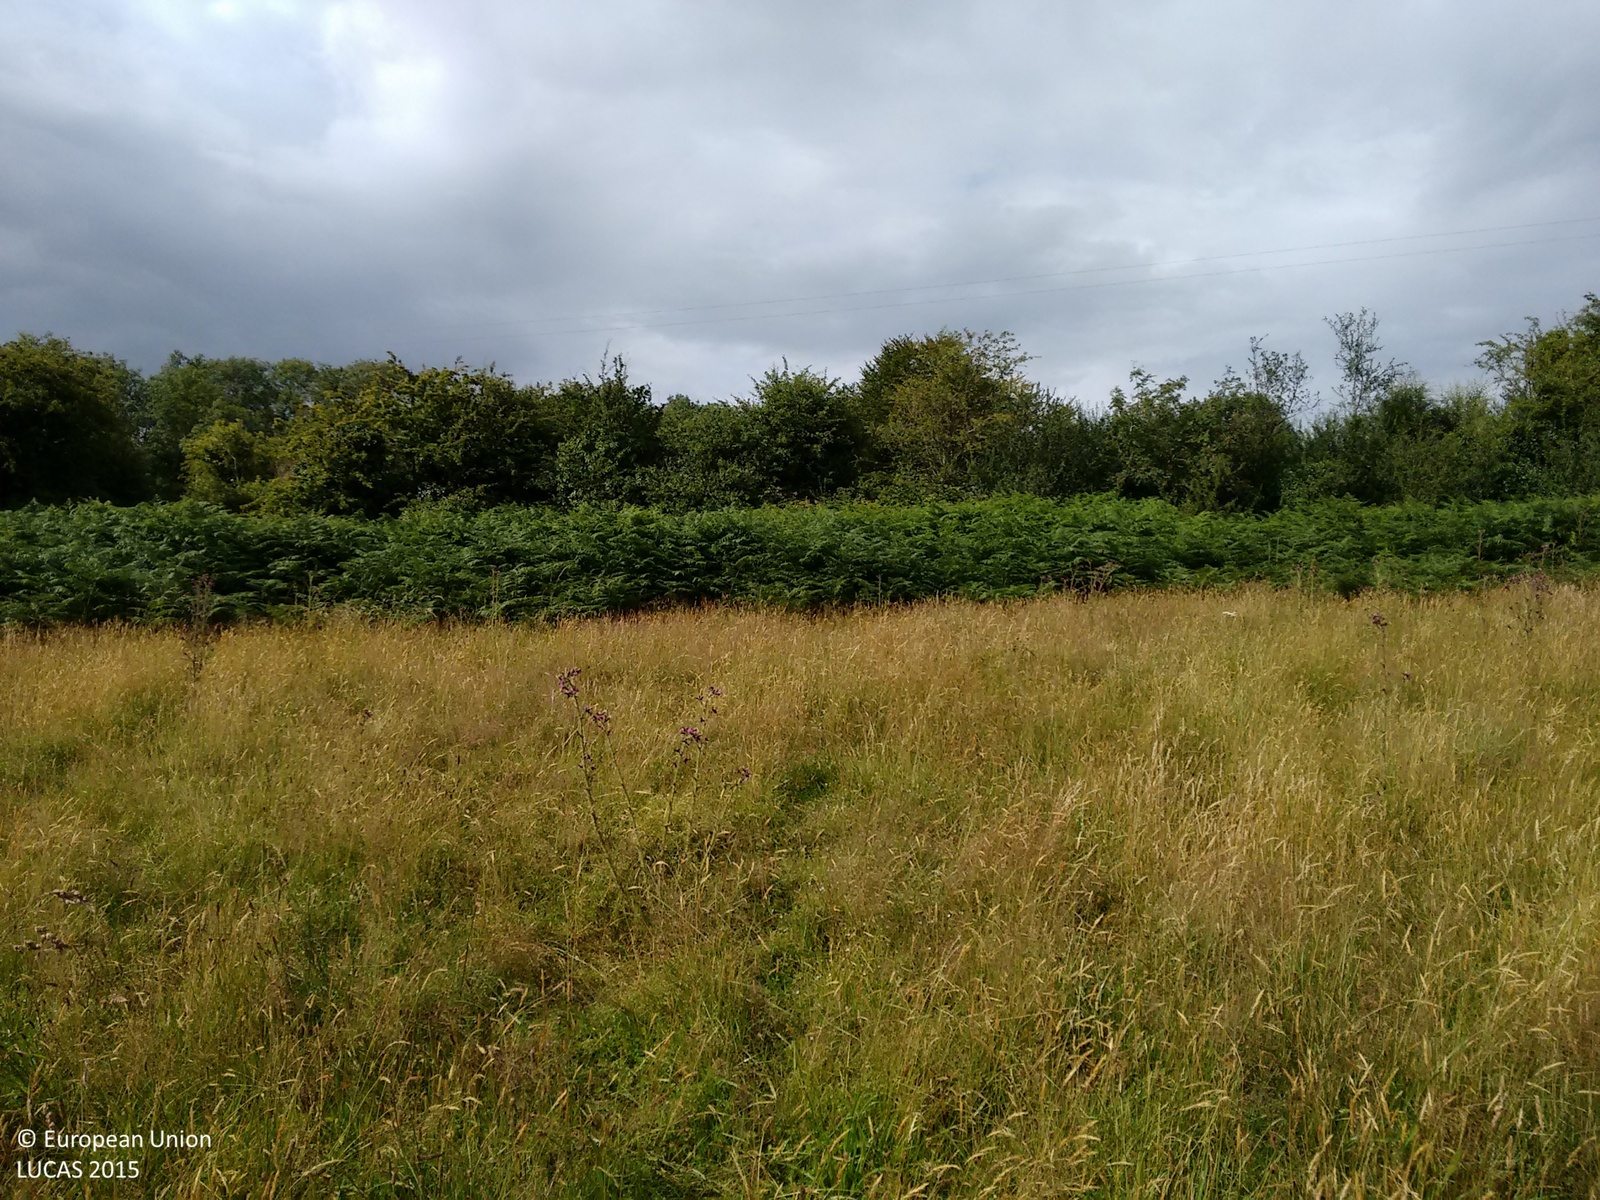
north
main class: Grassland
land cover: Grassland without tree/shrub cover
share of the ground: > 75 %
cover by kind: herbaceous plants 100 %
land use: Agriculture (excluding fallow land and kitchen gardens)
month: July
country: IE
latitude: 52.8365
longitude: -6.4399
